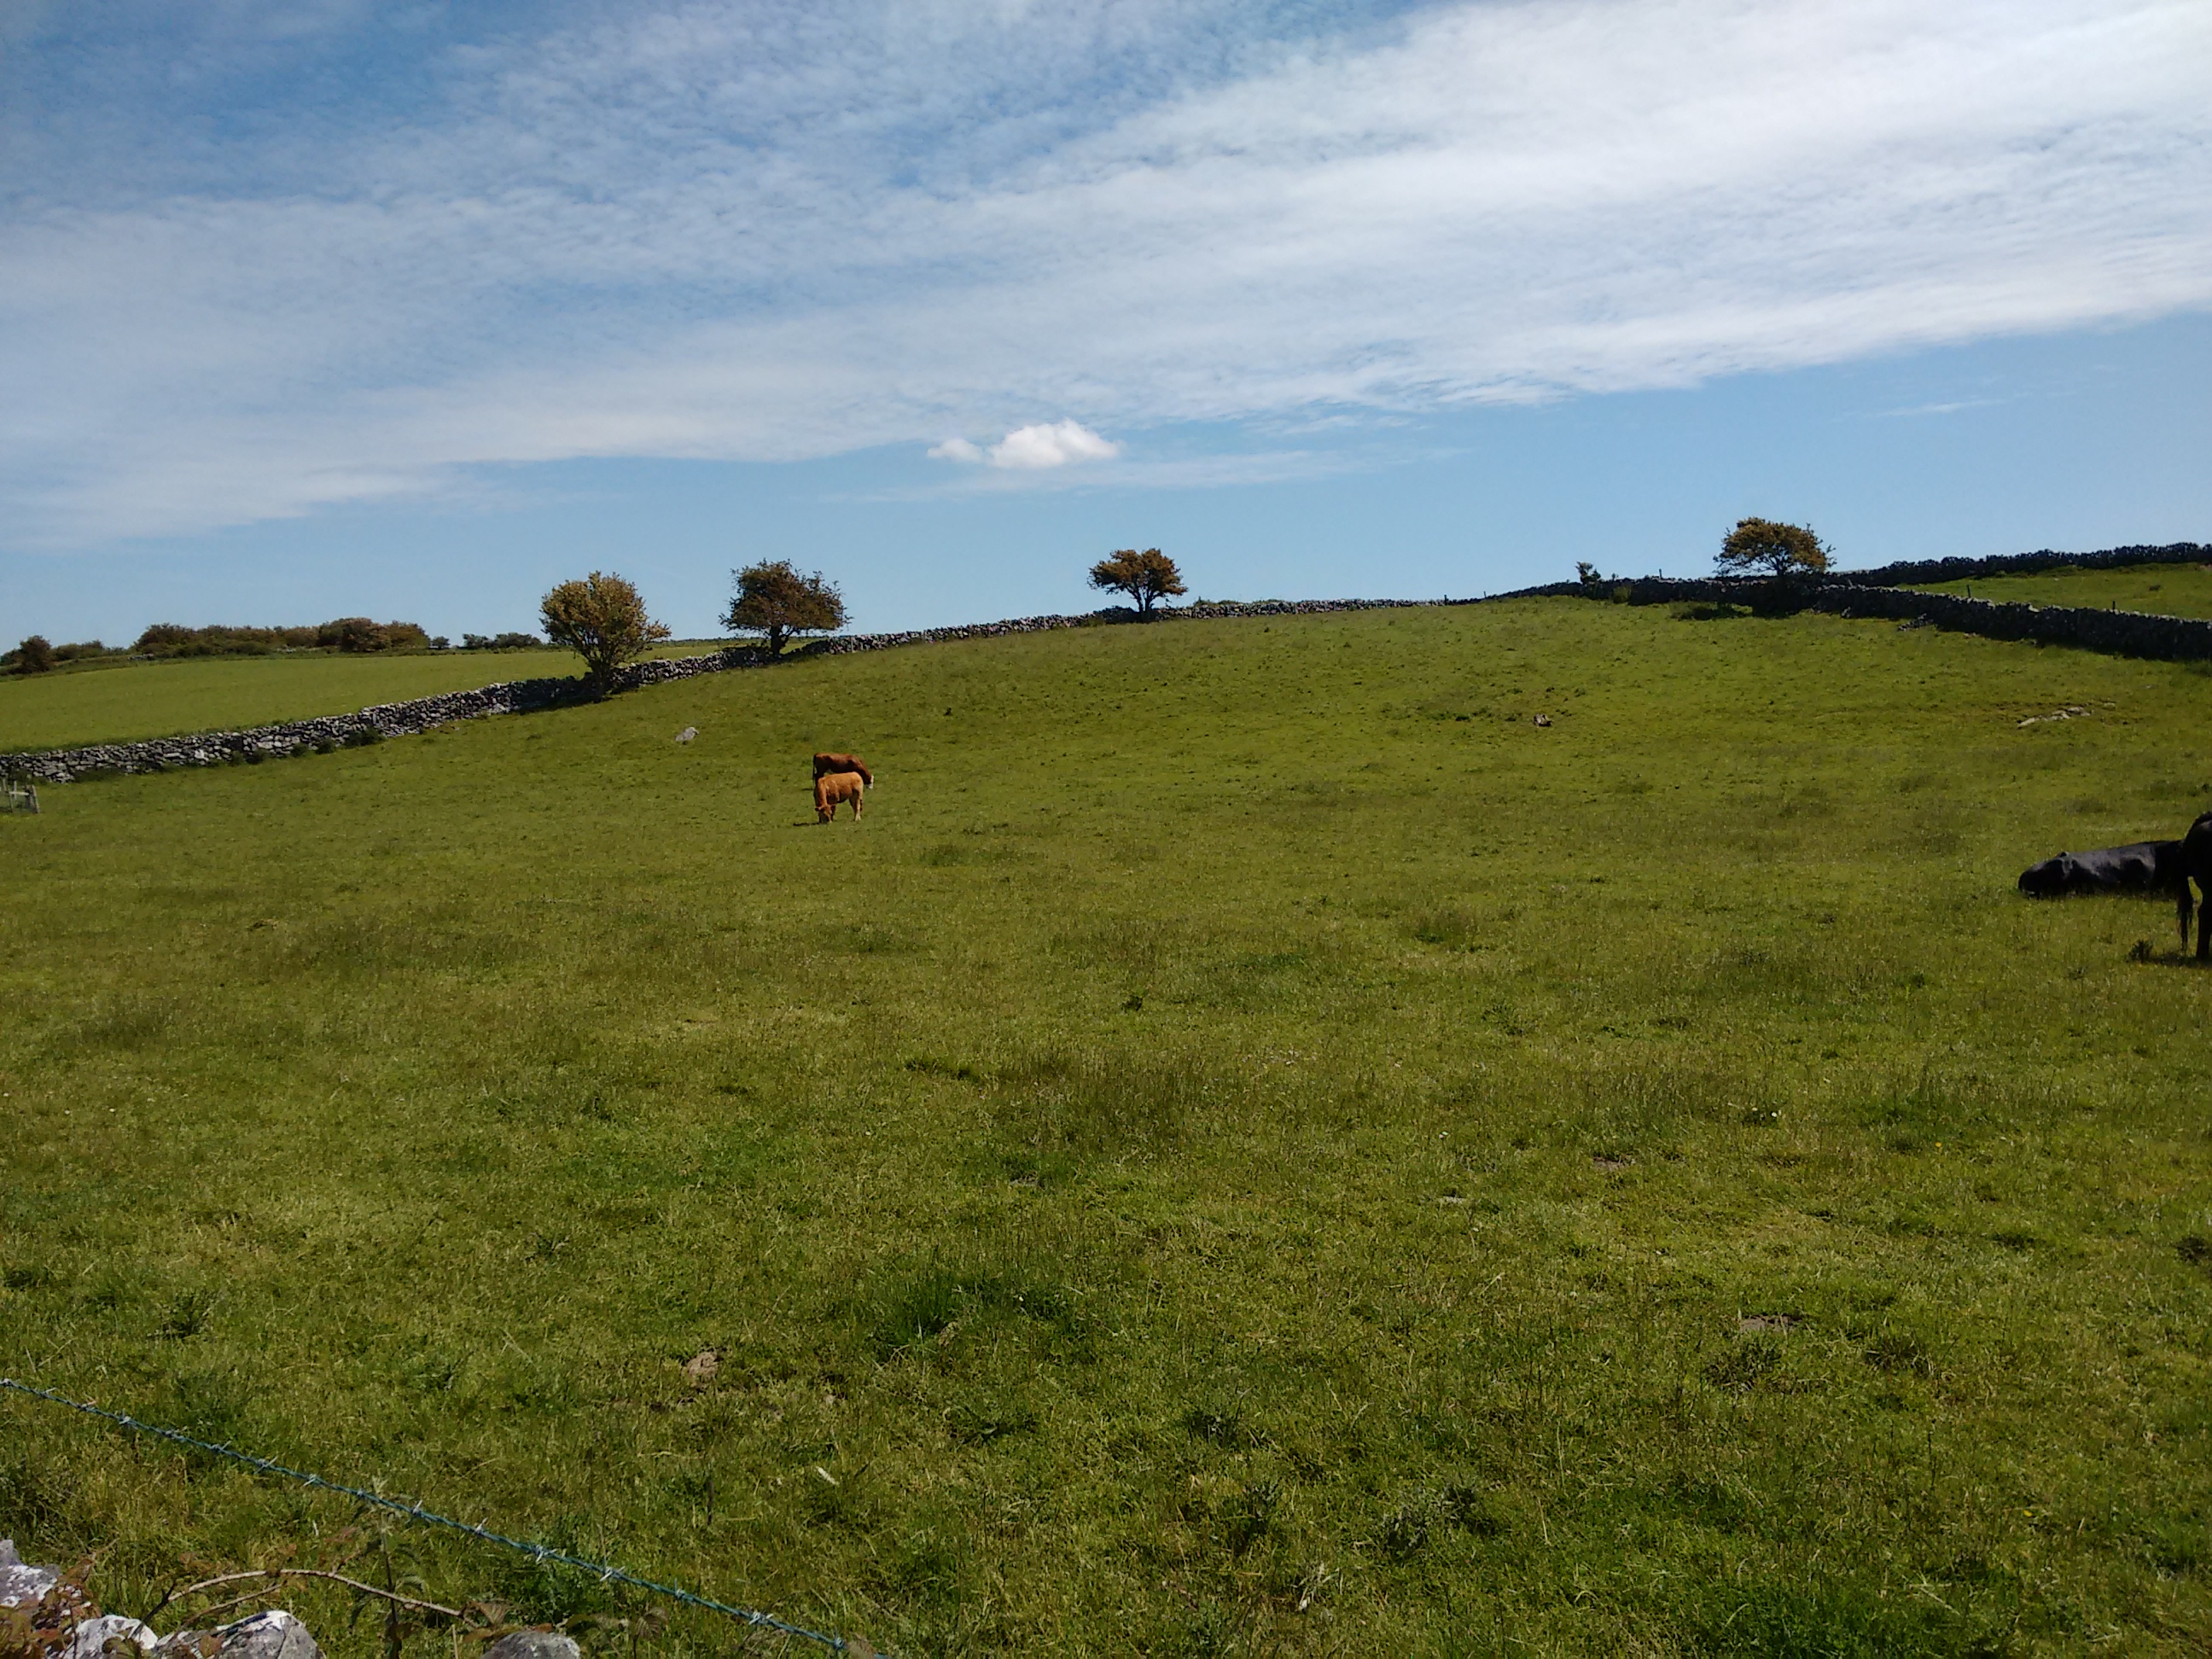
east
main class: Grassland
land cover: Grassland without tree/shrub cover
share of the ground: > 75 %
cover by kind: herbaceous plants 100 %
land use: Agriculture (excluding fallow land and kitchen gardens)
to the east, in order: Grassland without tree/shrub cover; Dry stone walls; Fences; Grassland without tree/shrub cover; Dry stone walls; Grassland without tree/shrub cover; Dry stone walls; Grassland without tree/shrub cover; Dry stone walls; Grassland without tree/shrub cover
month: June
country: IE
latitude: 53.2178
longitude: -8.9457
